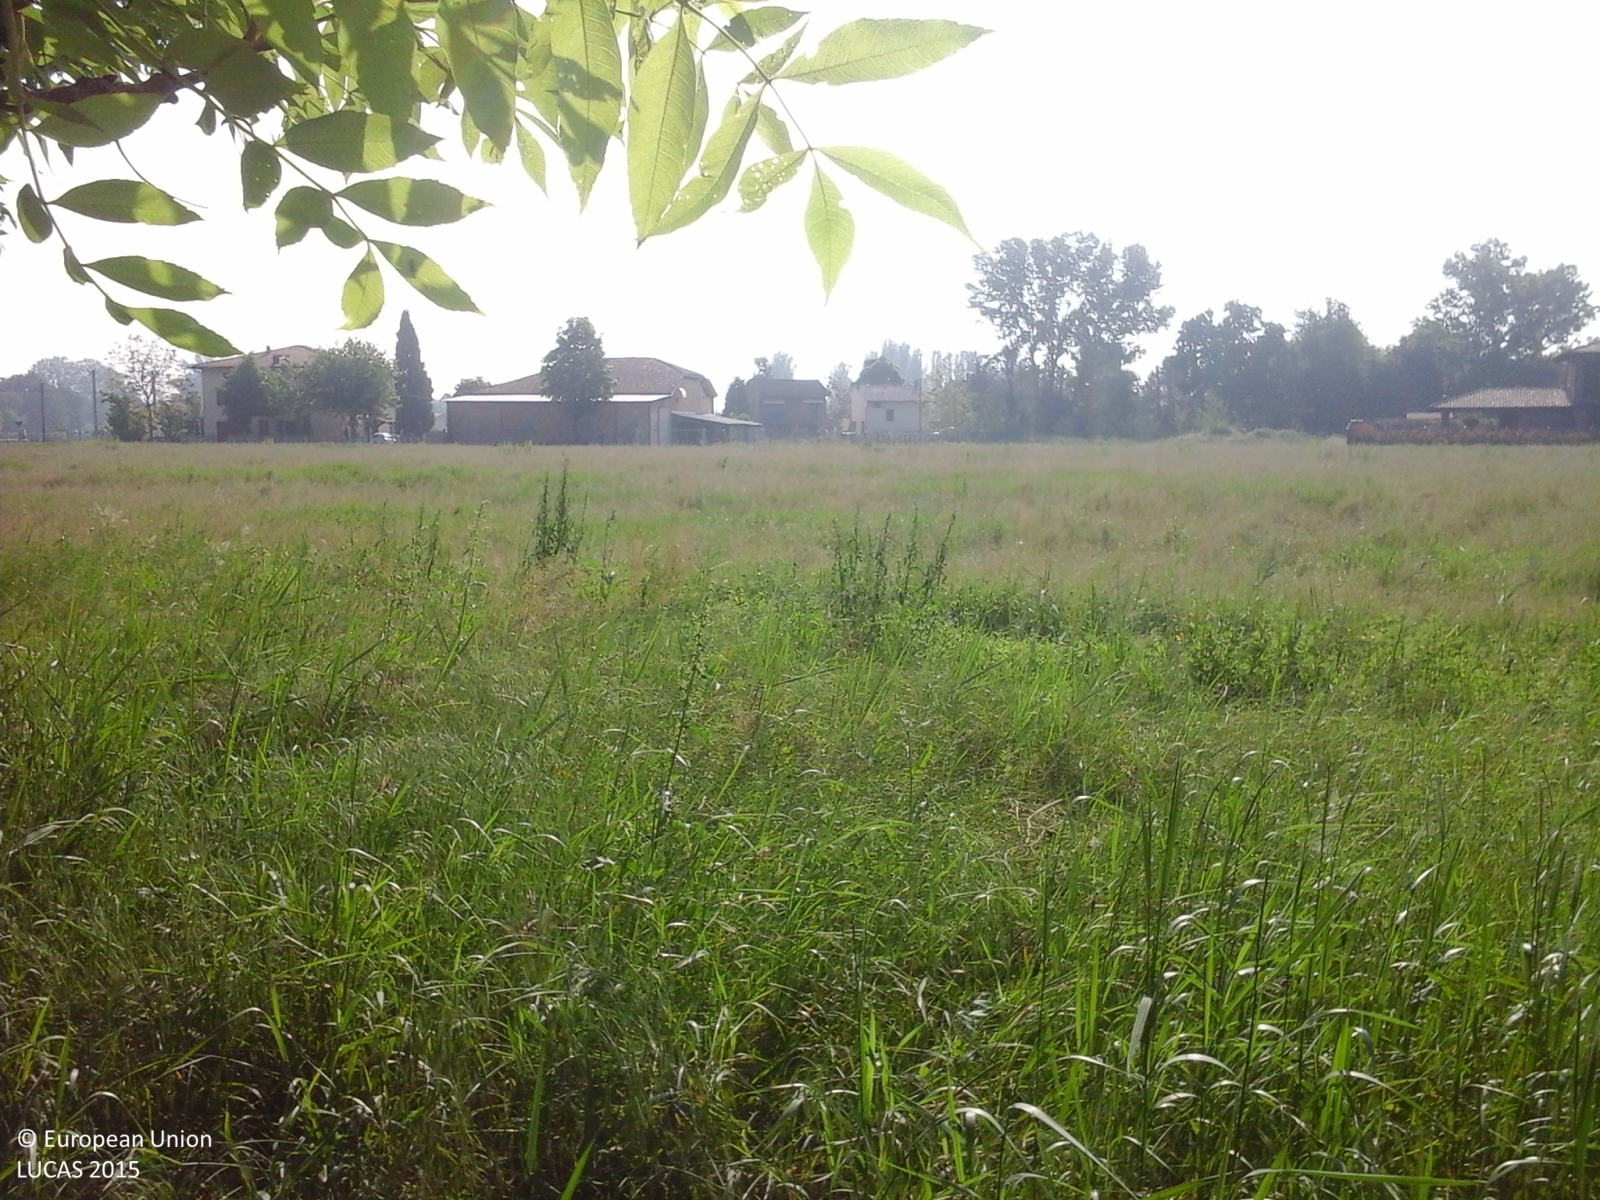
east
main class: Woodland
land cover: Broadleaved woodland
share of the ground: > 75 %
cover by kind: broadleaved forest trees 85 %, herbaceous plants 15 %
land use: Amenities, museums, leisure
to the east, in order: Broadleaved woodland; Grassland without tree/shrub cover; Ditches and canals; Grassland without tree/shrub cover; Ditches and canals; Artificial constructions in urban areas; Inland fresh running water; Artificial constructions in urban areas; Permanent crops (only in case pi)
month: May
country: IT
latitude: 44.5625
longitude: 10.9674
